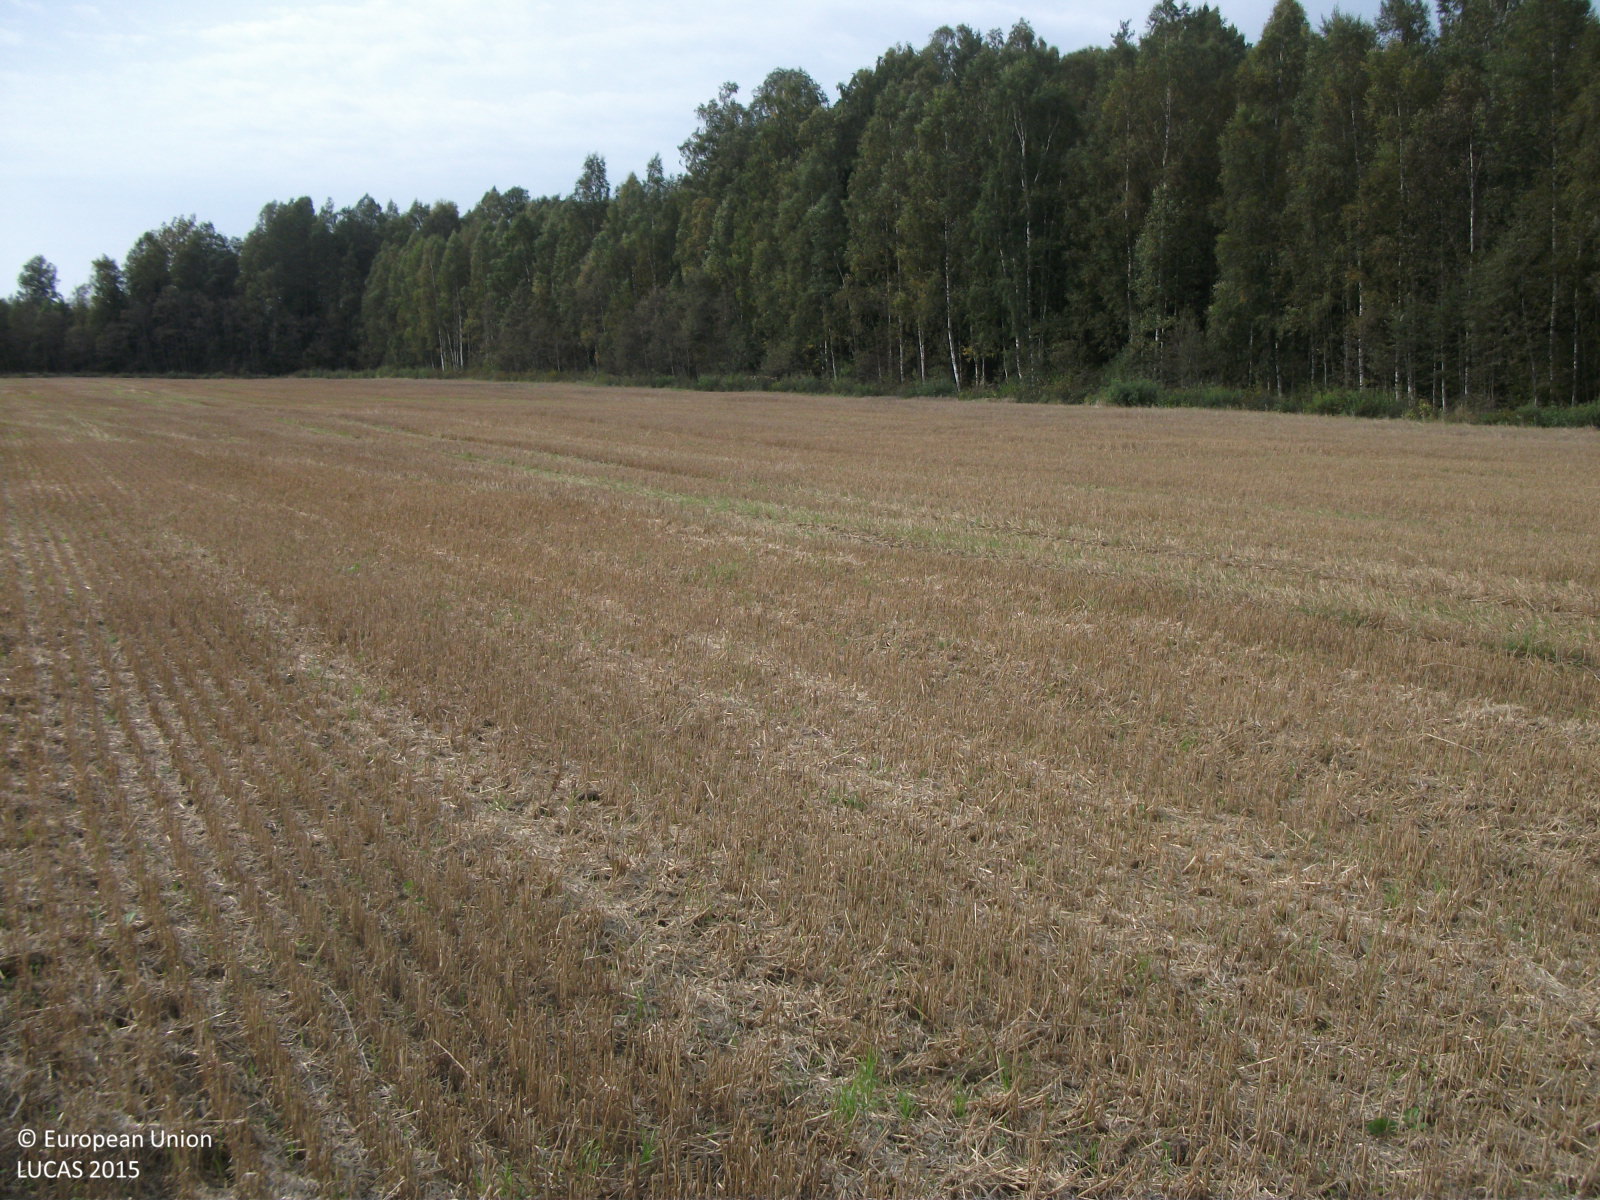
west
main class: Cropland
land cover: Common wheat
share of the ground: < 10 %
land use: Agriculture (excluding fallow land and kitchen gardens)
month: September
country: LV
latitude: 57.7073
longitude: 24.7810
